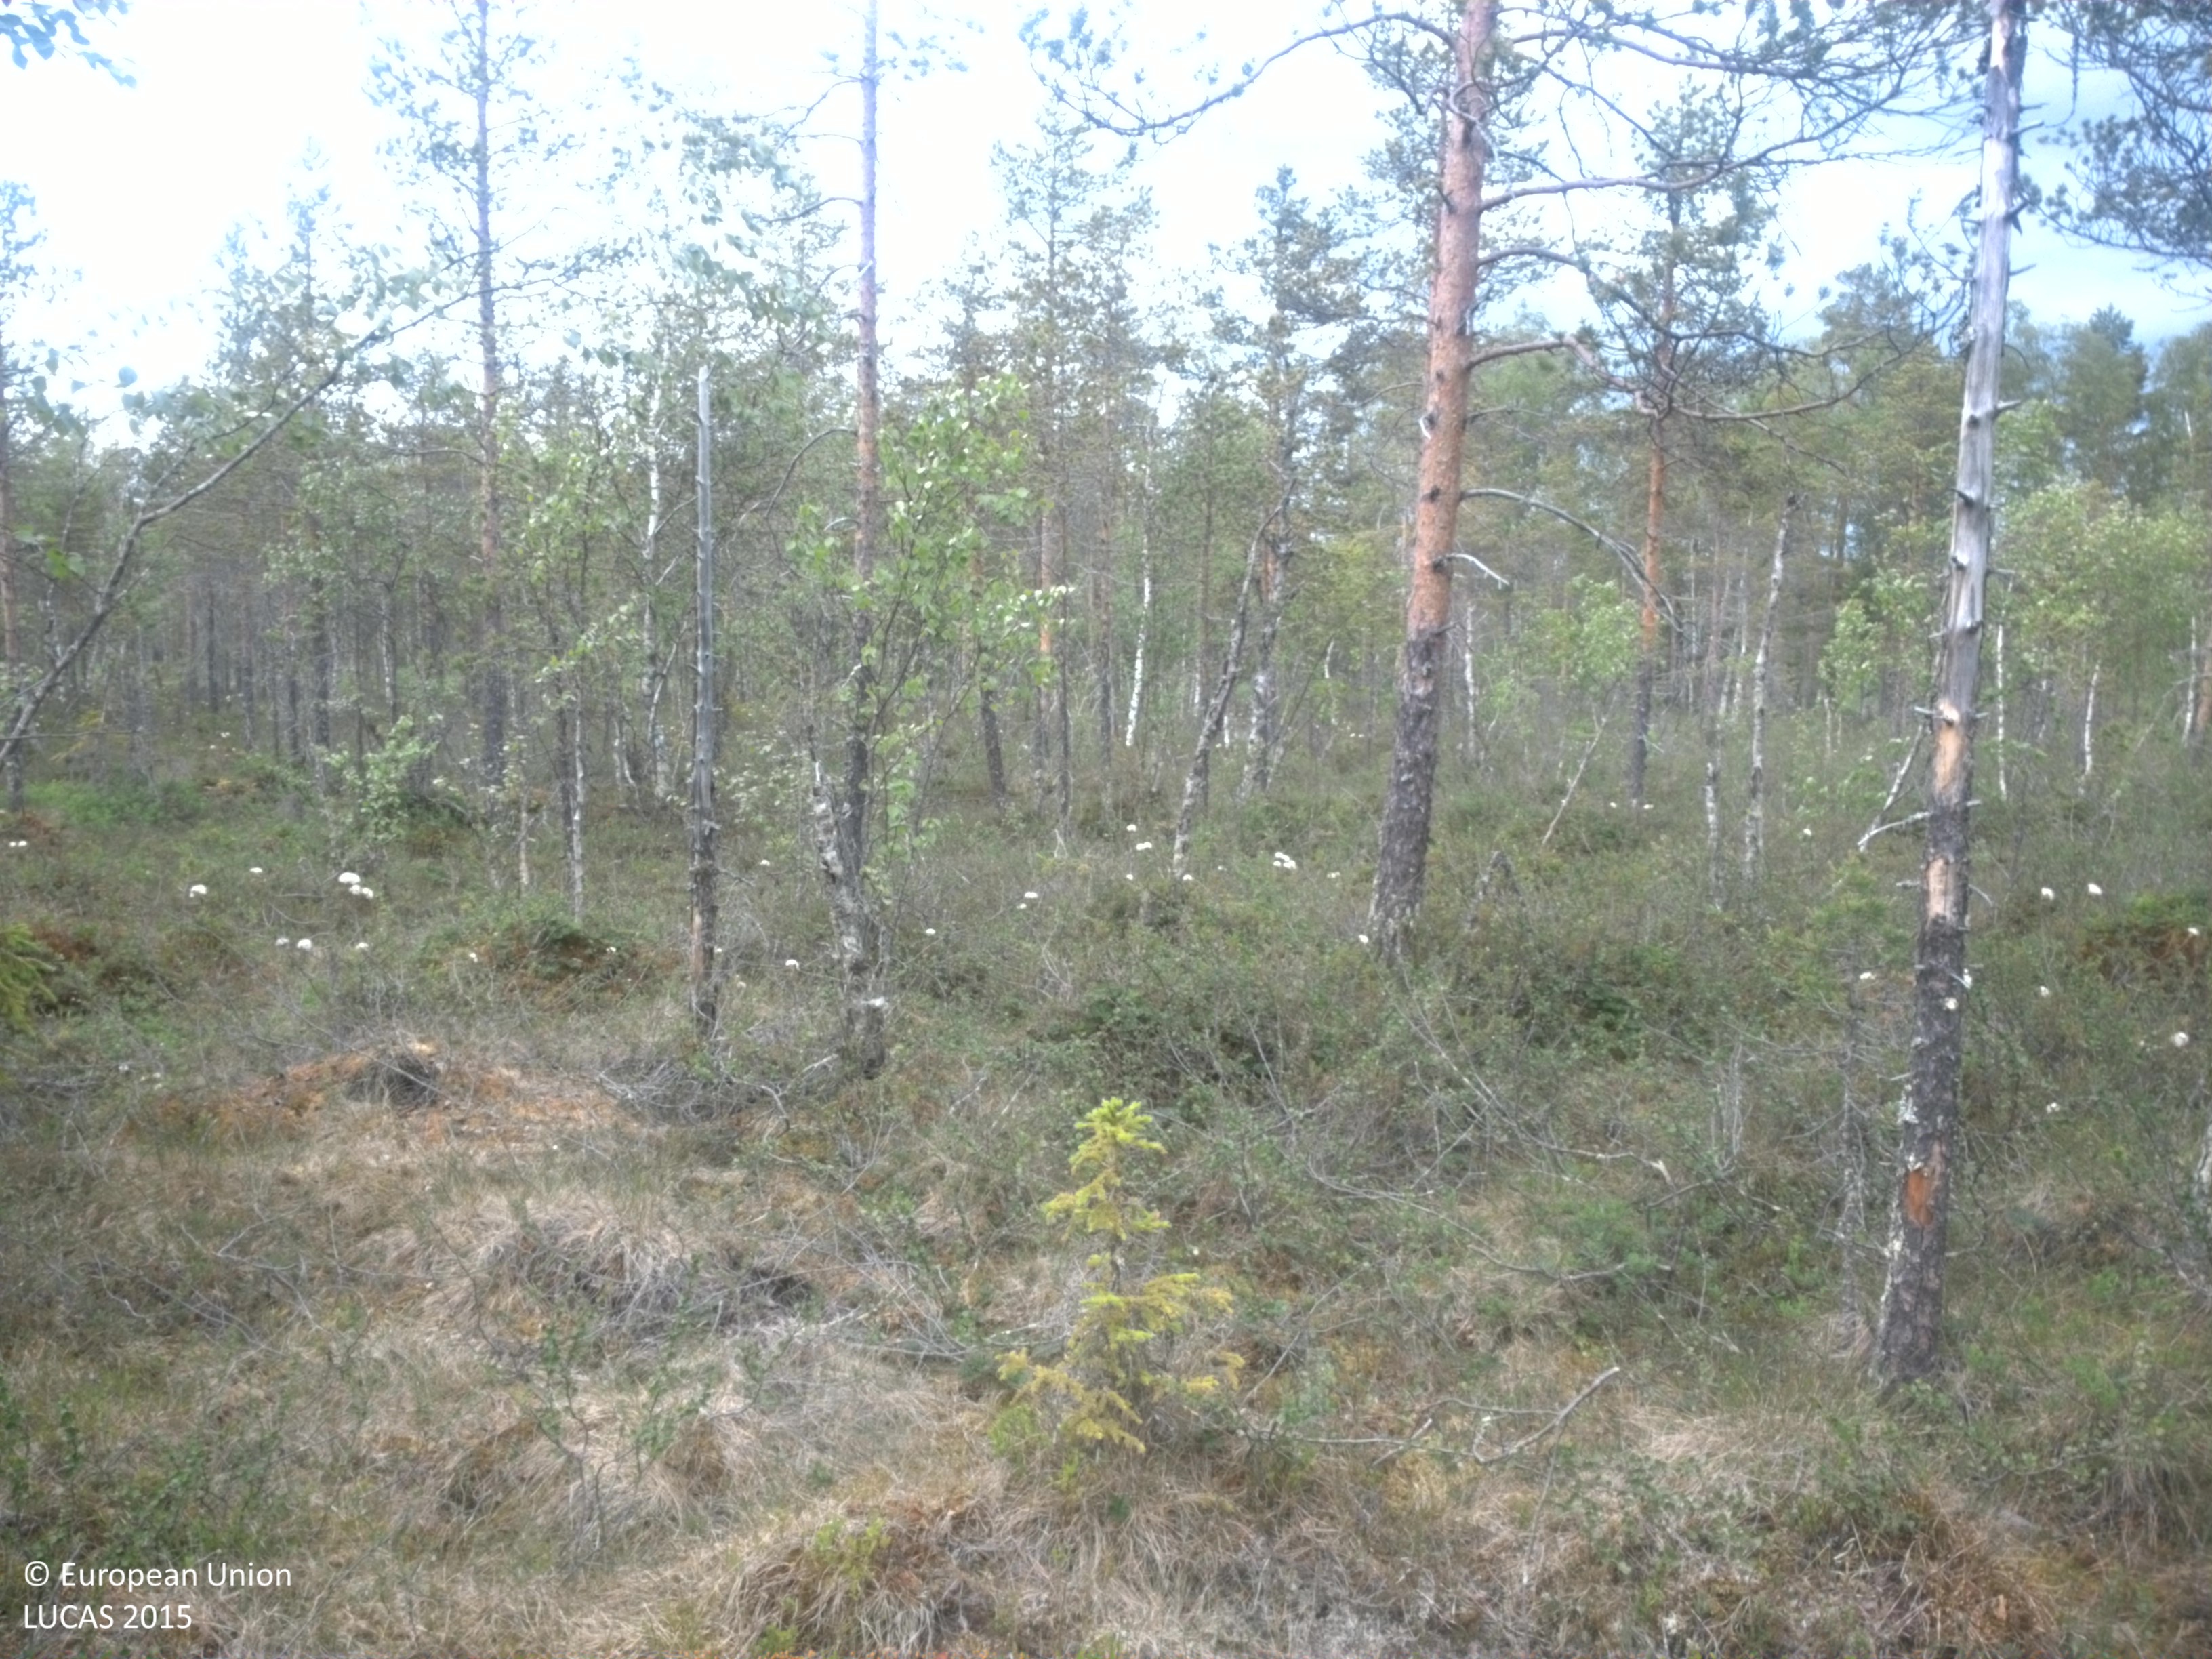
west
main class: Woodland
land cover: Pine dominated coniferous woodland
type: mire and swamp forests
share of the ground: 50 - 75 %
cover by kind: coniferous forest trees 45 %, shrubs 40 %, broadleaved forest trees 10 %, lichens and mosses 5 %
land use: Semi-natural and natural areas not in use
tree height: > 5 m
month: July
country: SE
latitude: 64.6546
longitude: 20.1698
